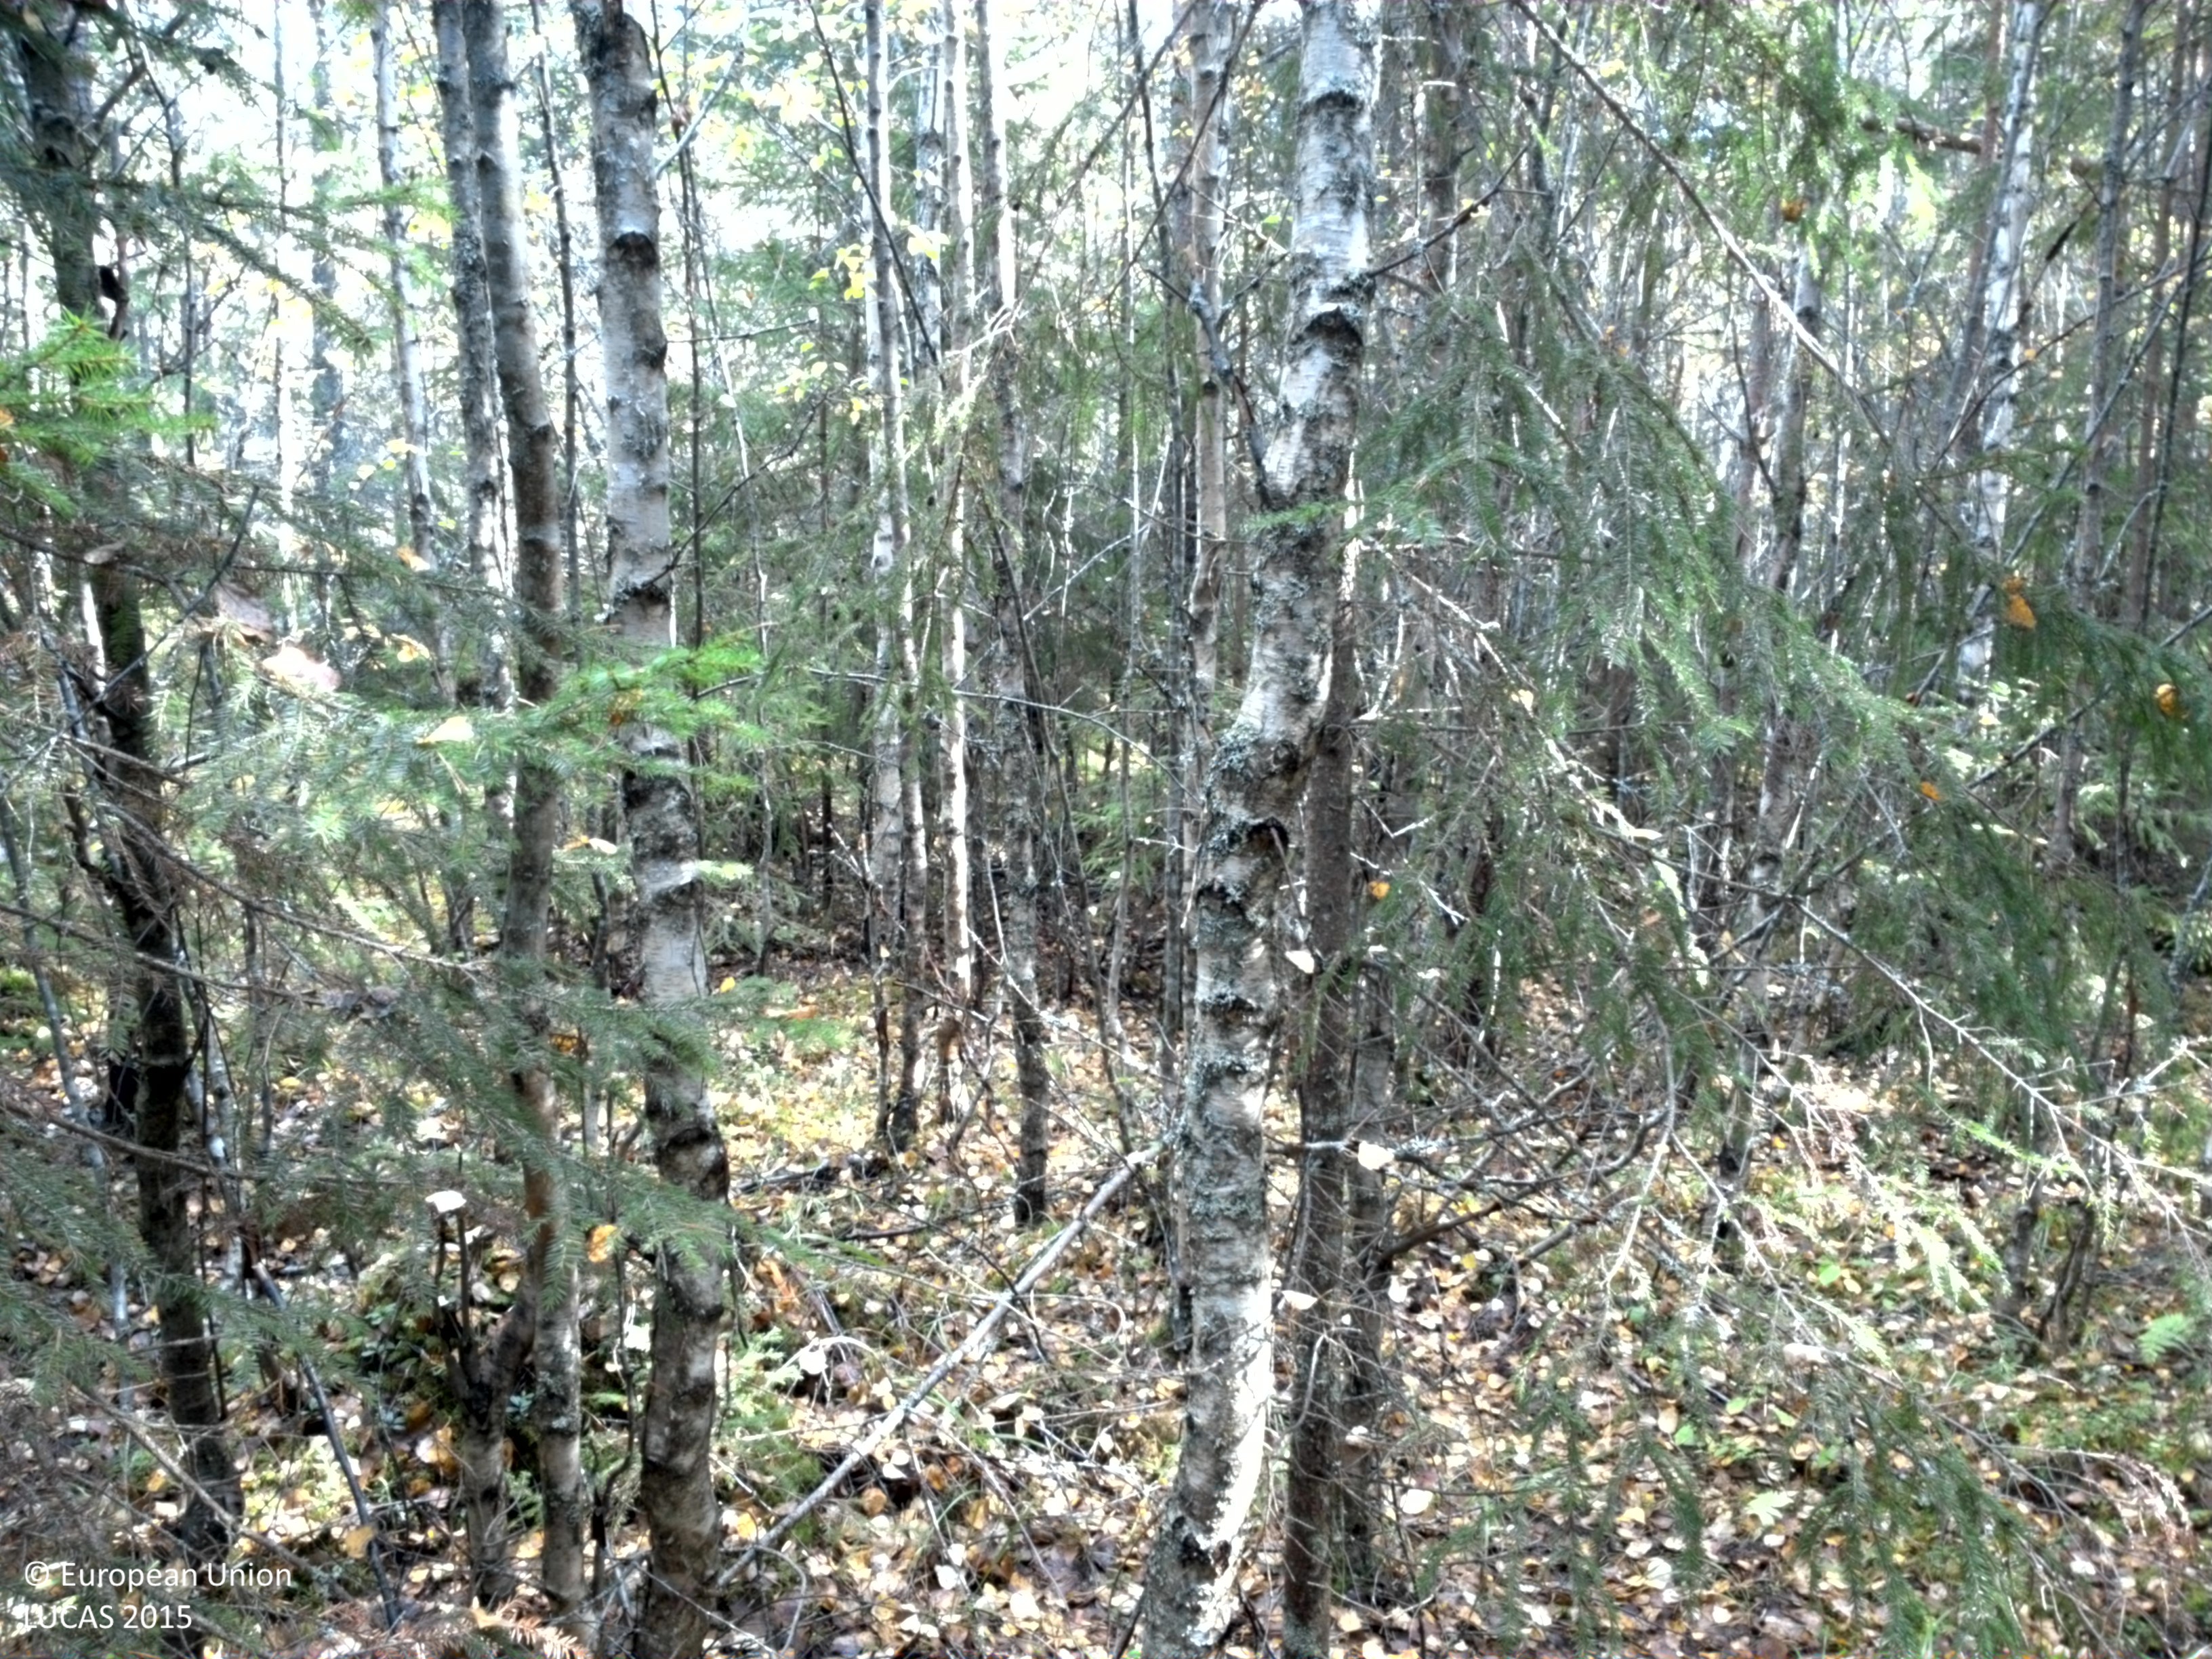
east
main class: Woodland
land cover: Pine dominated mixed woodland
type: boreal forest
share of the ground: 50 - 75 %
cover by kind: coniferous forest trees 45 %, lichens and mosses 30 %, broadleaved forest trees 15 %, herbaceous plants 10 %
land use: Forestry
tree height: > 5 m
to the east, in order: Pine dominated mixed woodland; Other coniferous woodland; Pine dominated coniferous woodland; Tracks; Pine dominated coniferous woodland
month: September
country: SE
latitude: 60.1218
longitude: 16.4867
